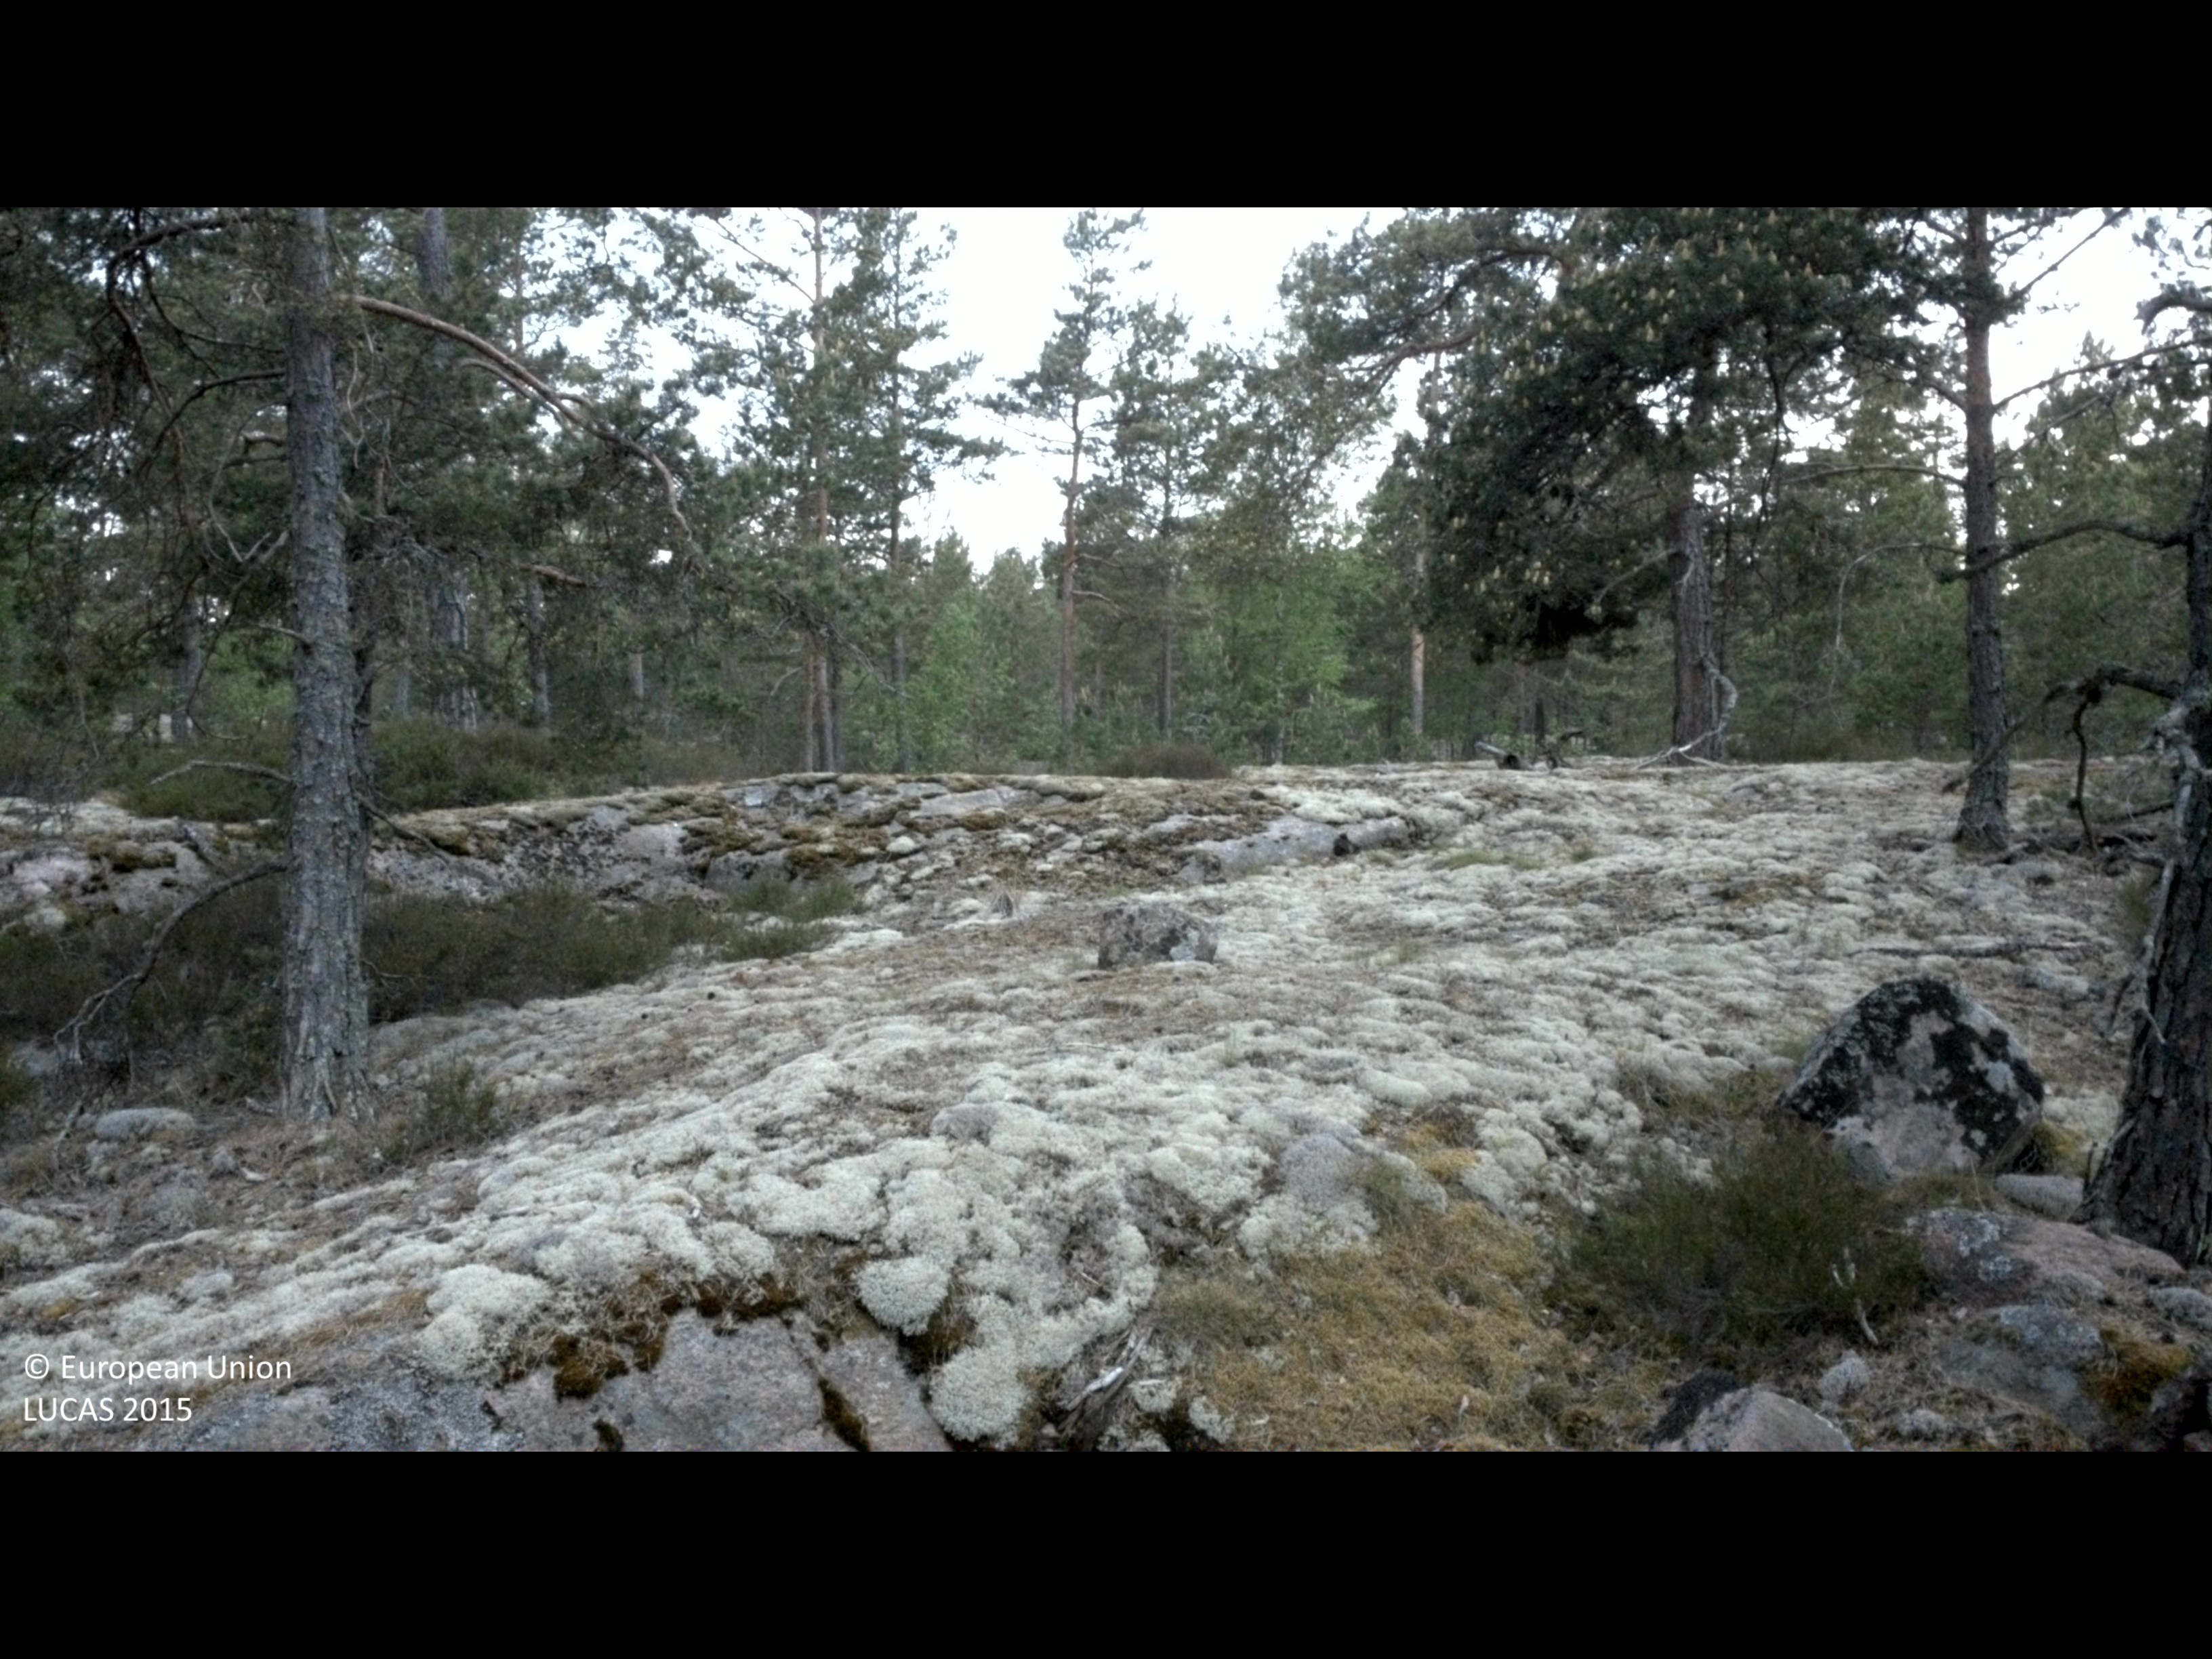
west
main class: Woodland
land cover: Pine dominated coniferous woodland
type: boreal forest
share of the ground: 50 - 75 %
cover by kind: coniferous forest trees 60 %, shrubs 20 %, lichens and mosses 15 %, broadleaved forest trees 5 %
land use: Forestry
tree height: > 5 m
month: May
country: SE
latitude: 57.4770
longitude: 16.6537
